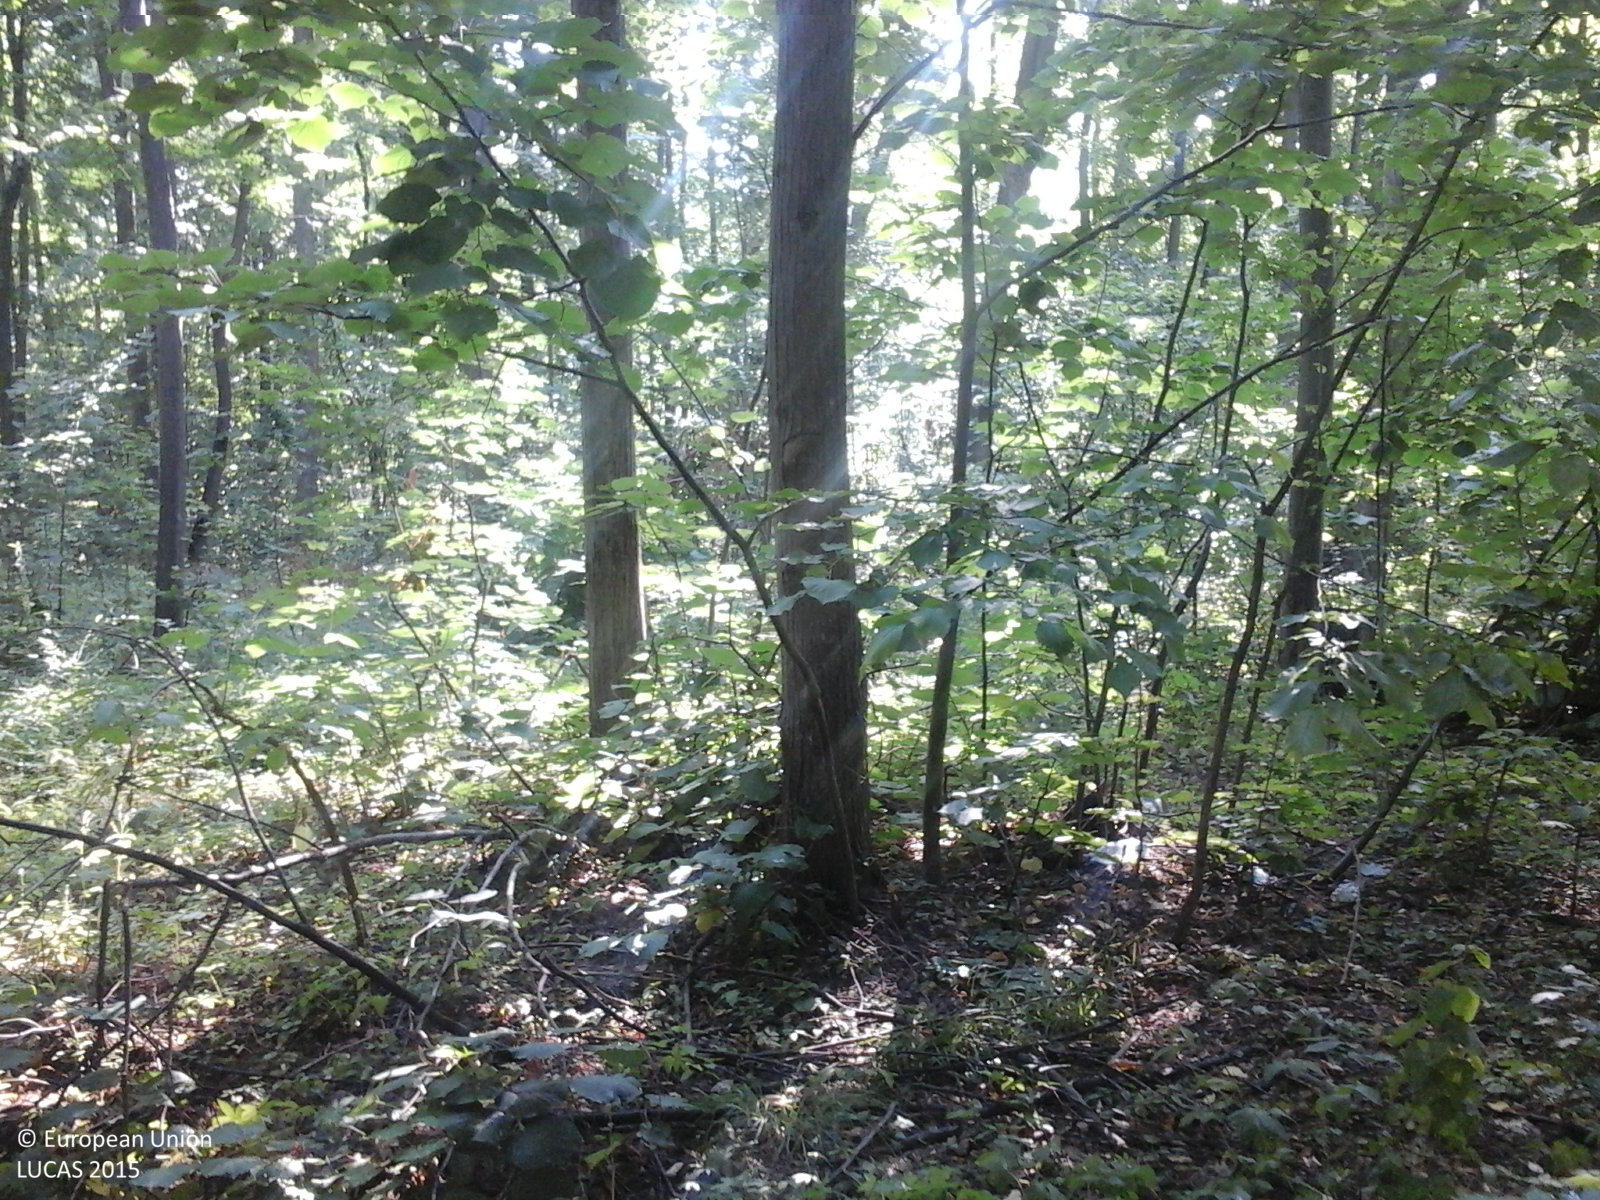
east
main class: Woodland
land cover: Broadleaved woodland
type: mesophytic deciduous forest
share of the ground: > 75 %
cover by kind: broadleaved forest trees 90 %, herbaceous plants 10 %
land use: Forestry
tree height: > 5 m
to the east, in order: Broadleaved woodland
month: July
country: RO
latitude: 46.0540
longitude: 27.2778
